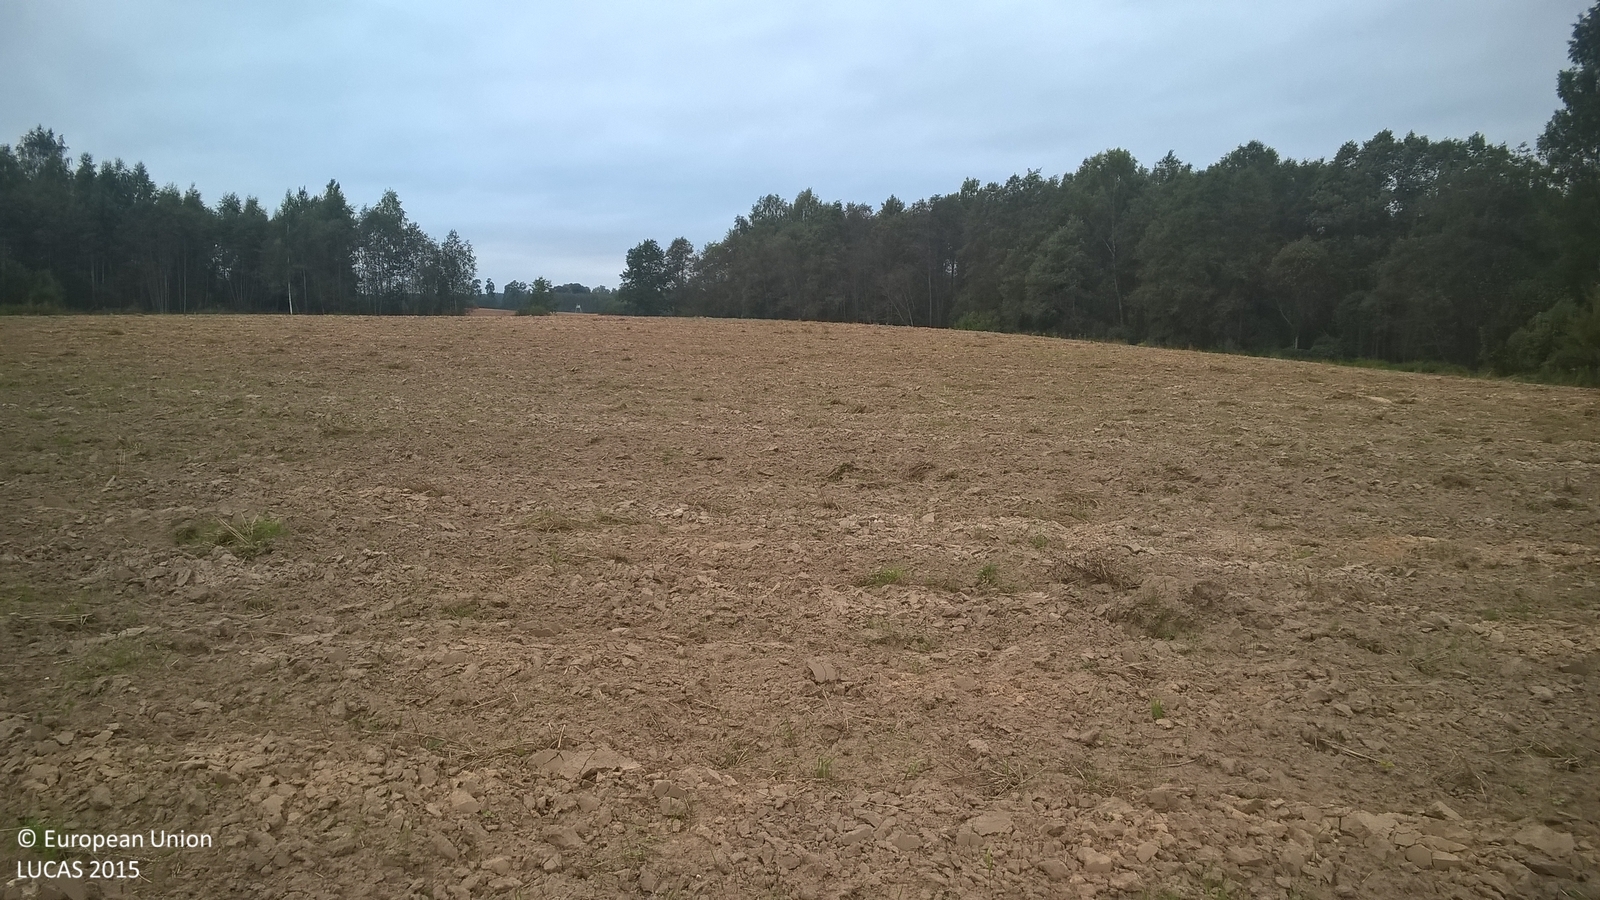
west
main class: Cropland
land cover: Rye
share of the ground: < 10 %
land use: Agriculture (excluding fallow land and kitchen gardens)
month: September
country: LV
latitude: 57.5521
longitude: 25.6430
